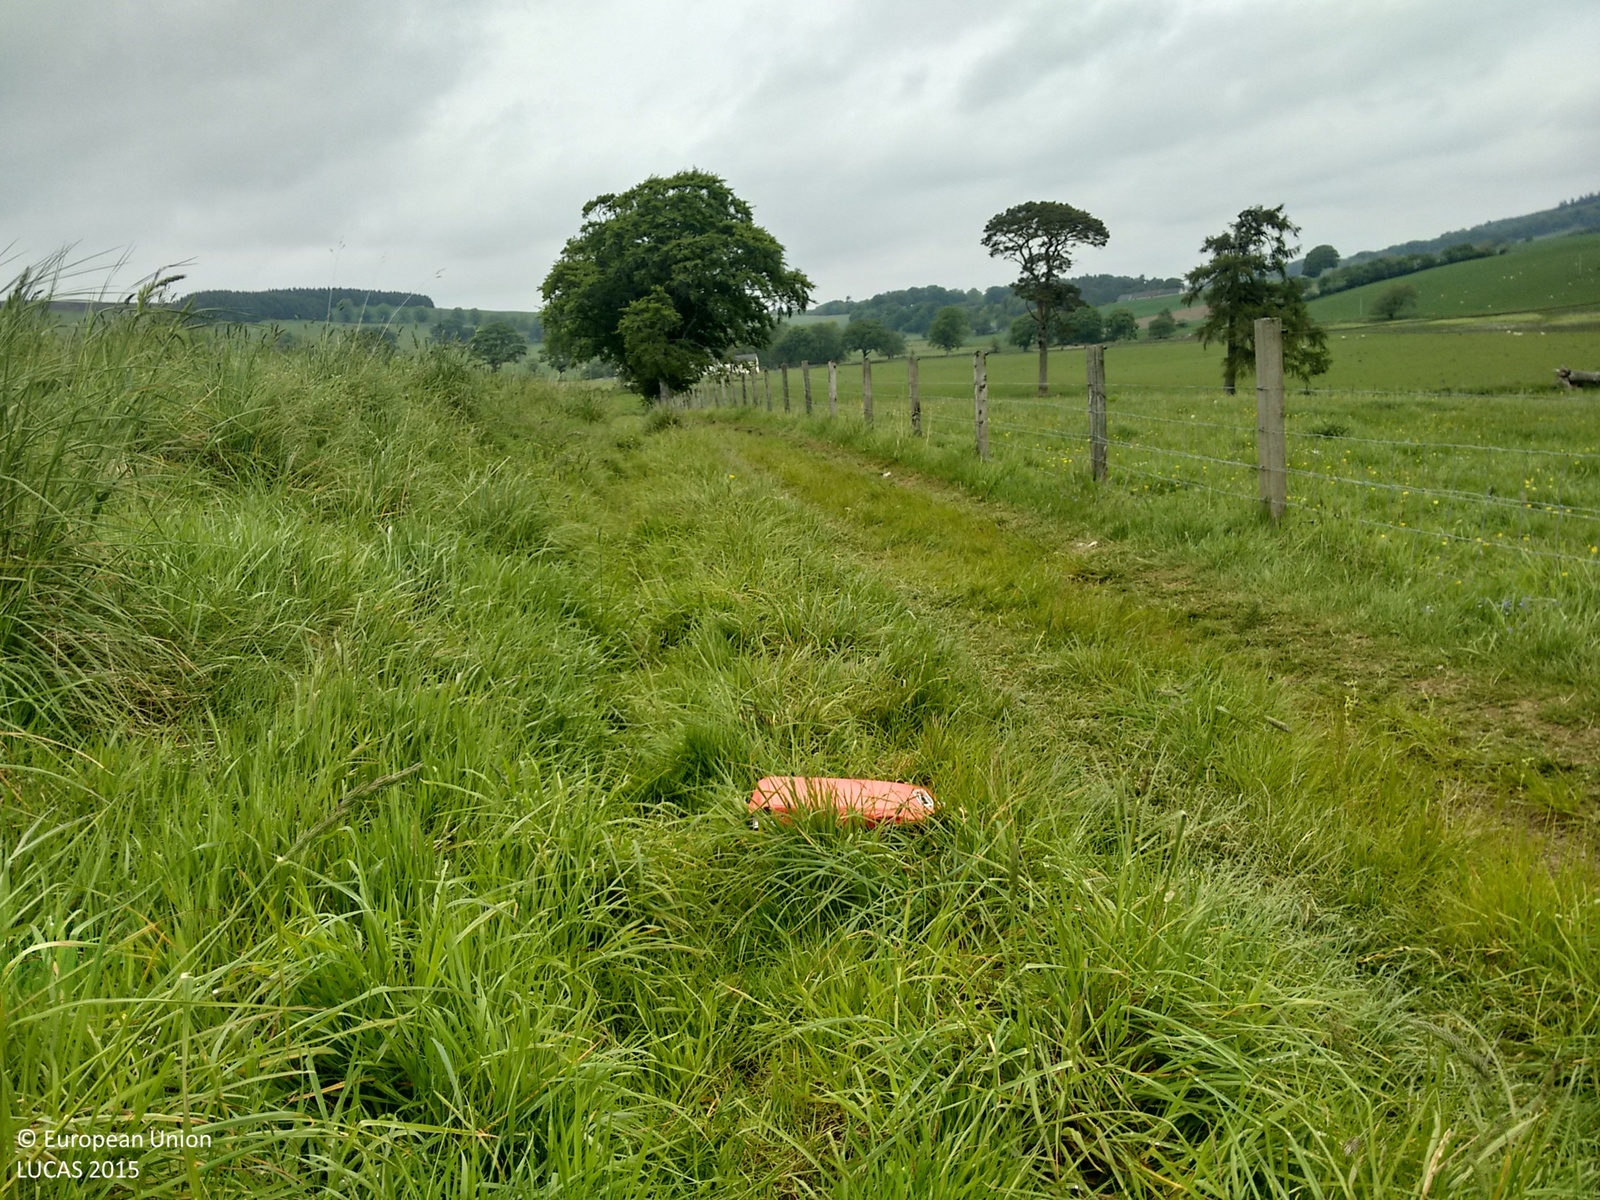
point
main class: Grassland
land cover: Grassland without tree/shrub cover
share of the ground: > 75 %
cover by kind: herbaceous plants 100 %
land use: Agriculture (excluding fallow land and kitchen gardens)
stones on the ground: < 10 %
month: June
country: GB
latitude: 55.6308
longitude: -3.5325
